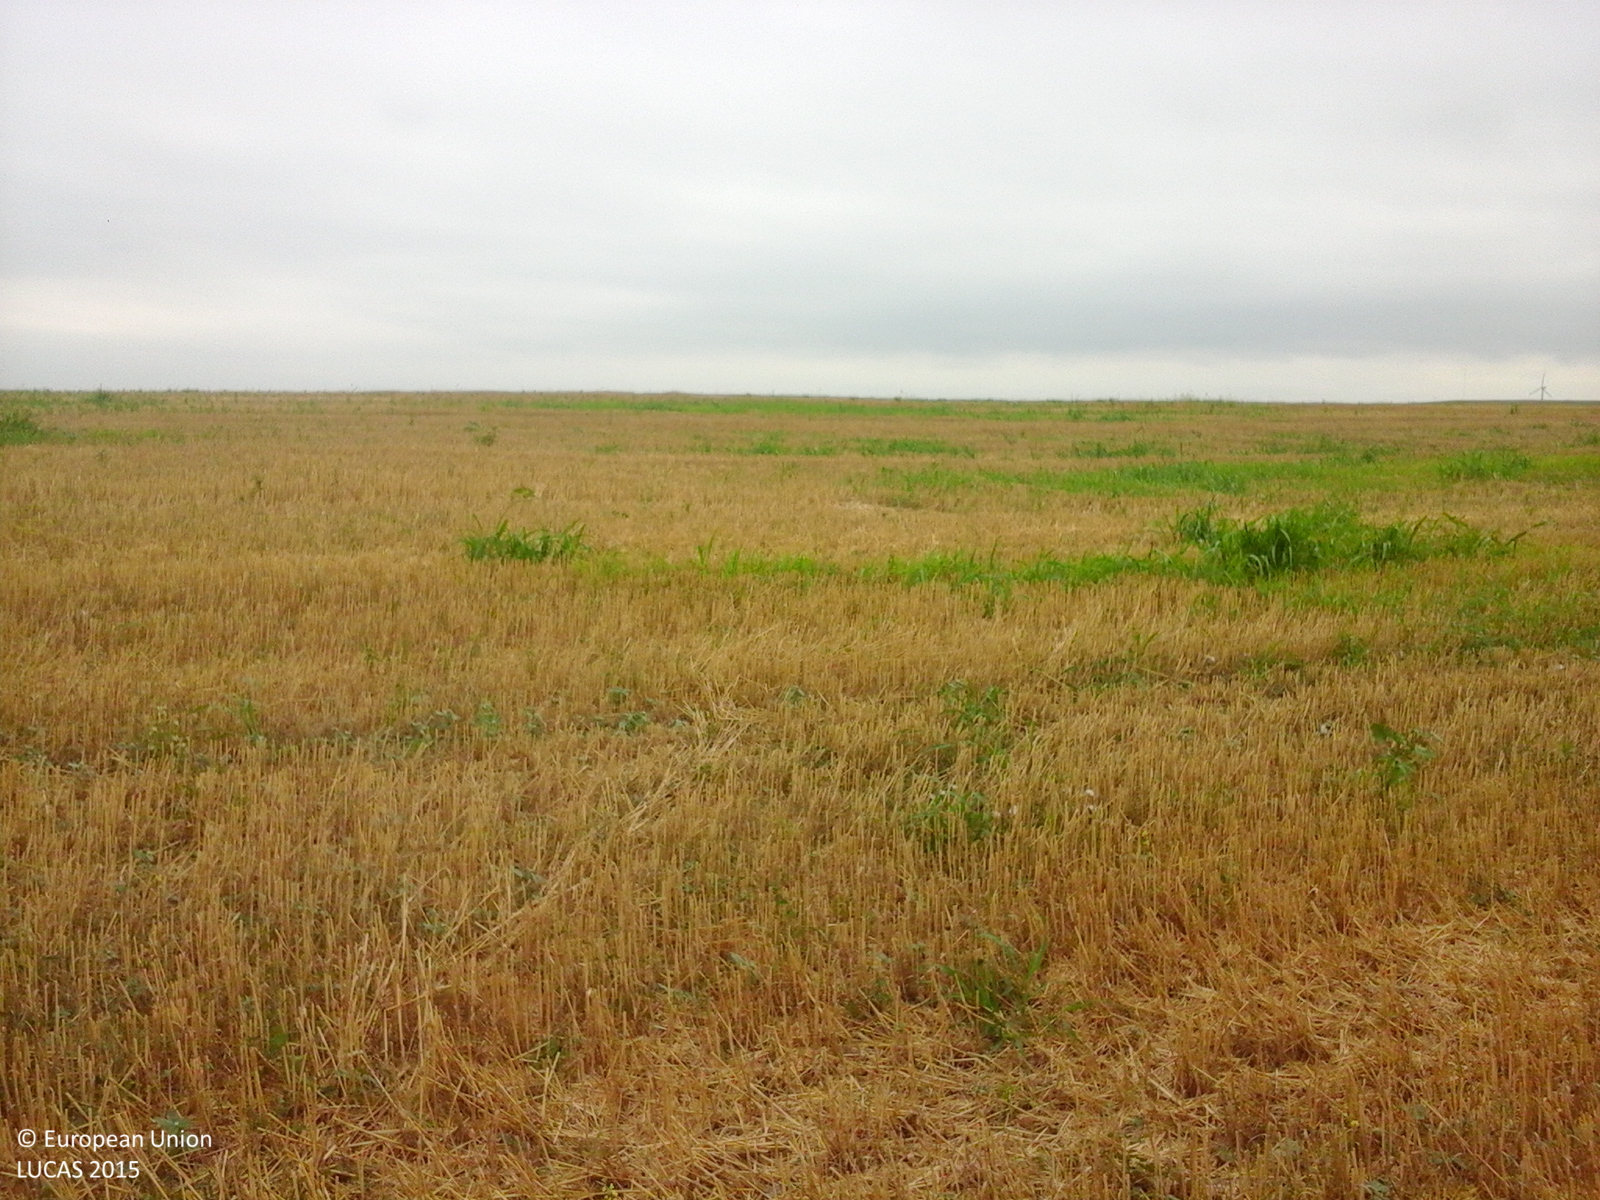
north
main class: Cropland
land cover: Durum wheat
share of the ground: 50 - 75 %
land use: Agriculture (excluding fallow land and kitchen gardens)
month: August
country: RO
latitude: 44.8424
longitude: 28.2221
